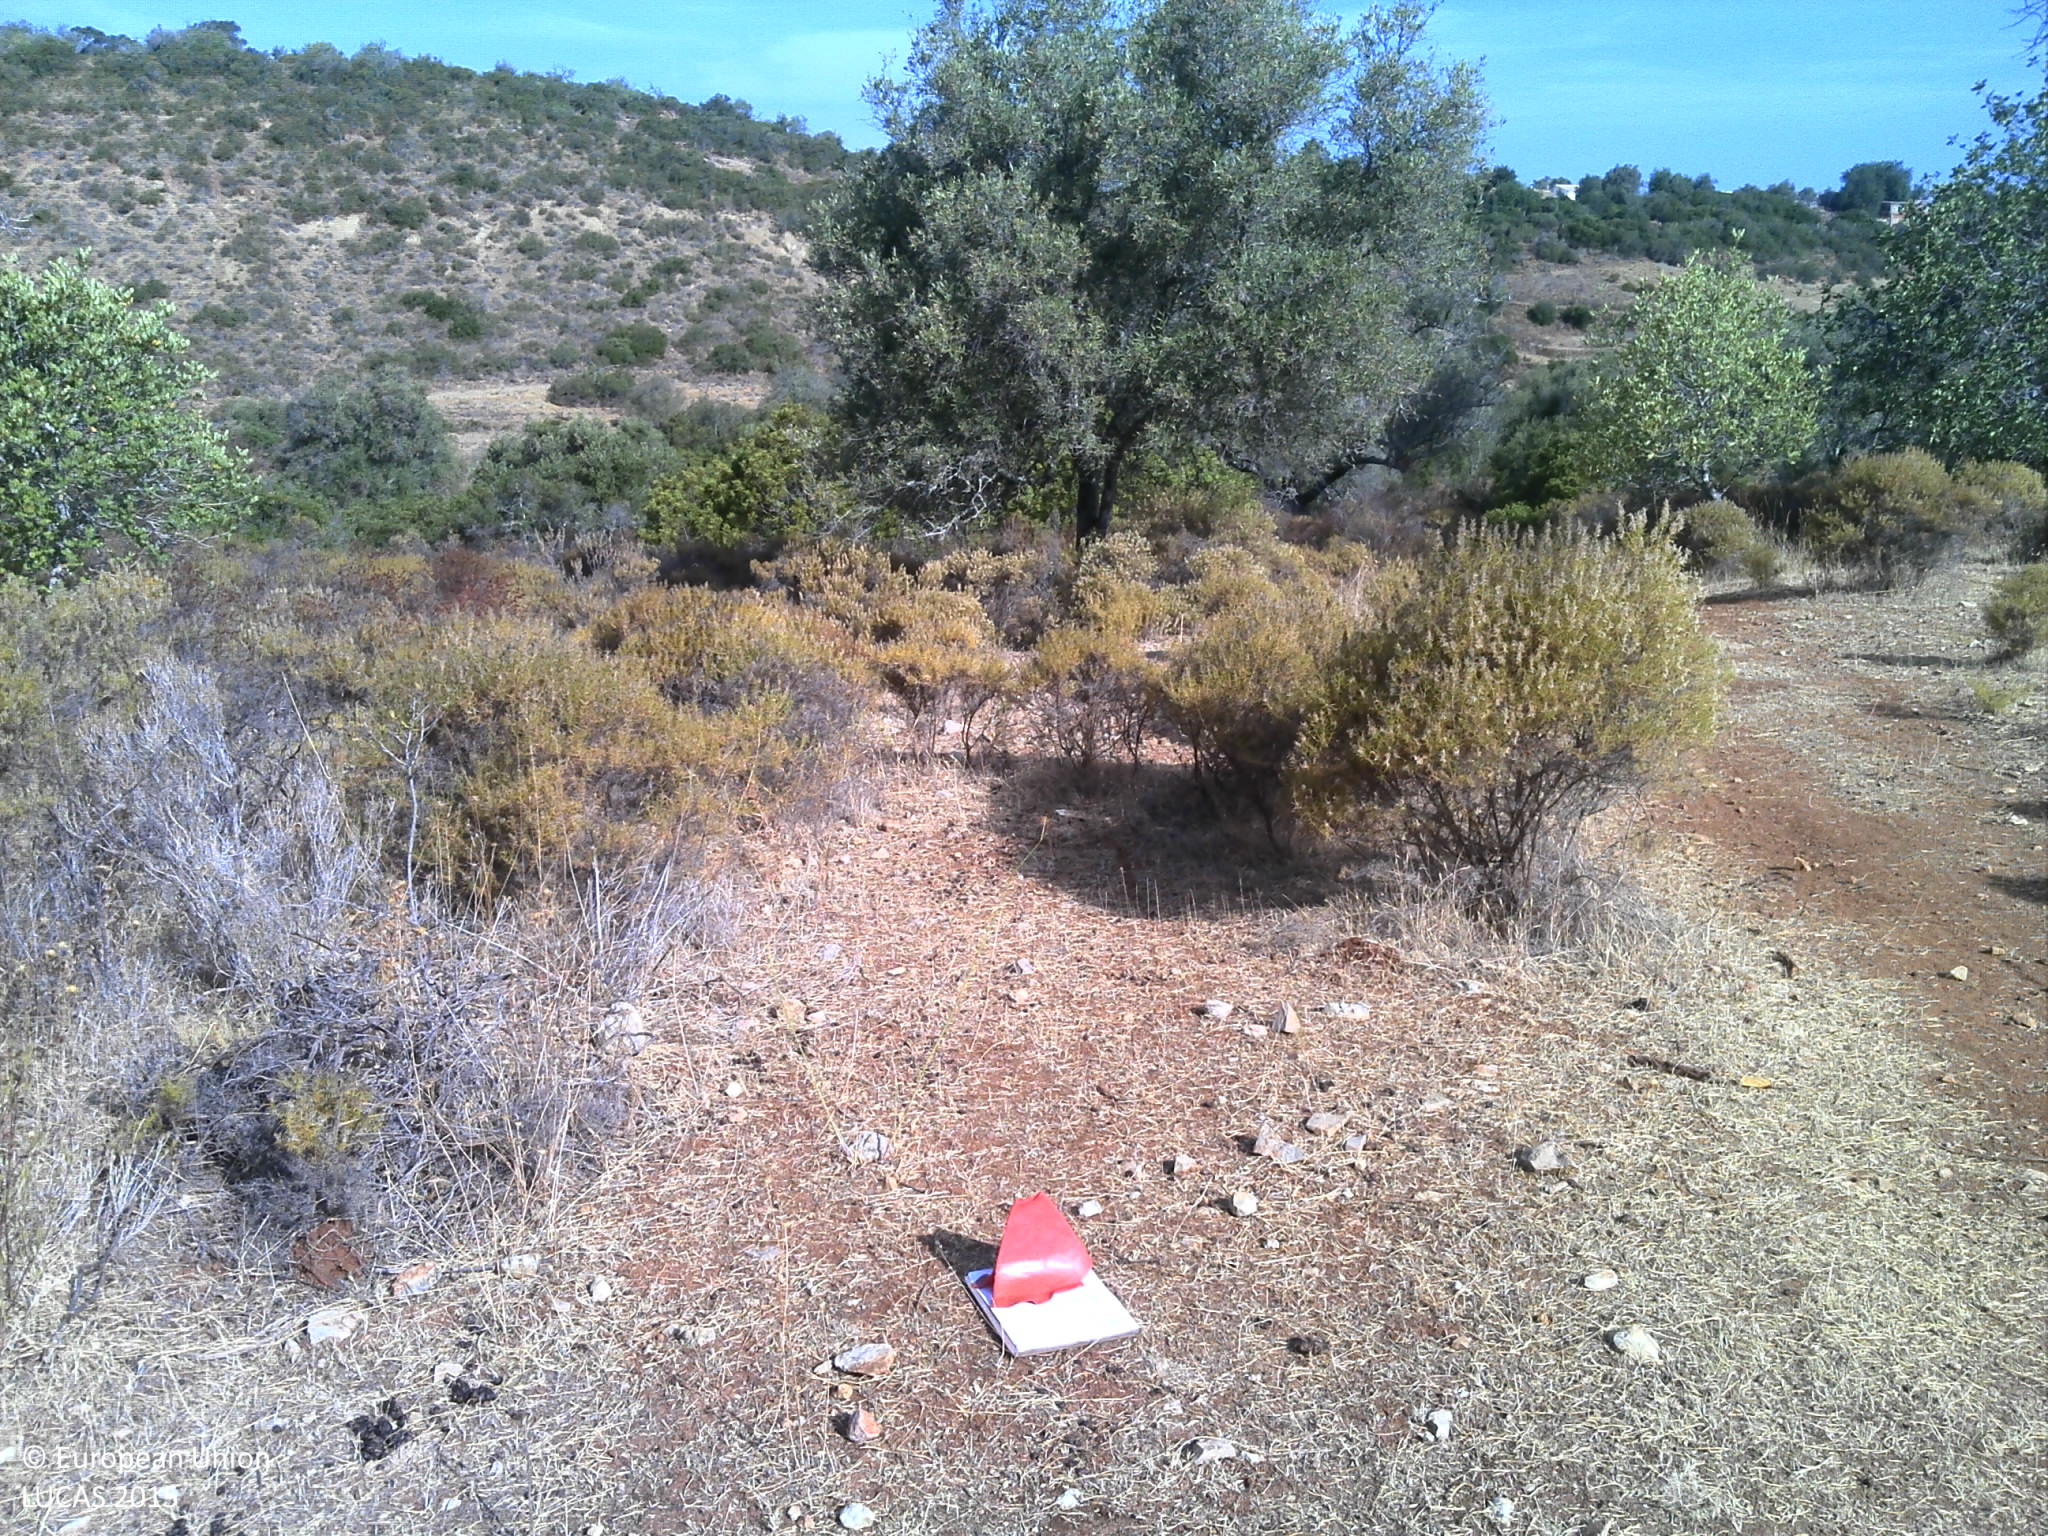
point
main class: Shrubland
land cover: Shrubland with sparse tree cover
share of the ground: 25 - 50 %
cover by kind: shrubs 40 %, unconsolidated bare surface 35 %, herbaceous plants 20 %, broadleaved forest trees 5 %
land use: Agriculture (excluding fallow land and kitchen gardens)
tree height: < 5 m
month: September
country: PT
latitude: 37.1432
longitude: -8.3839
